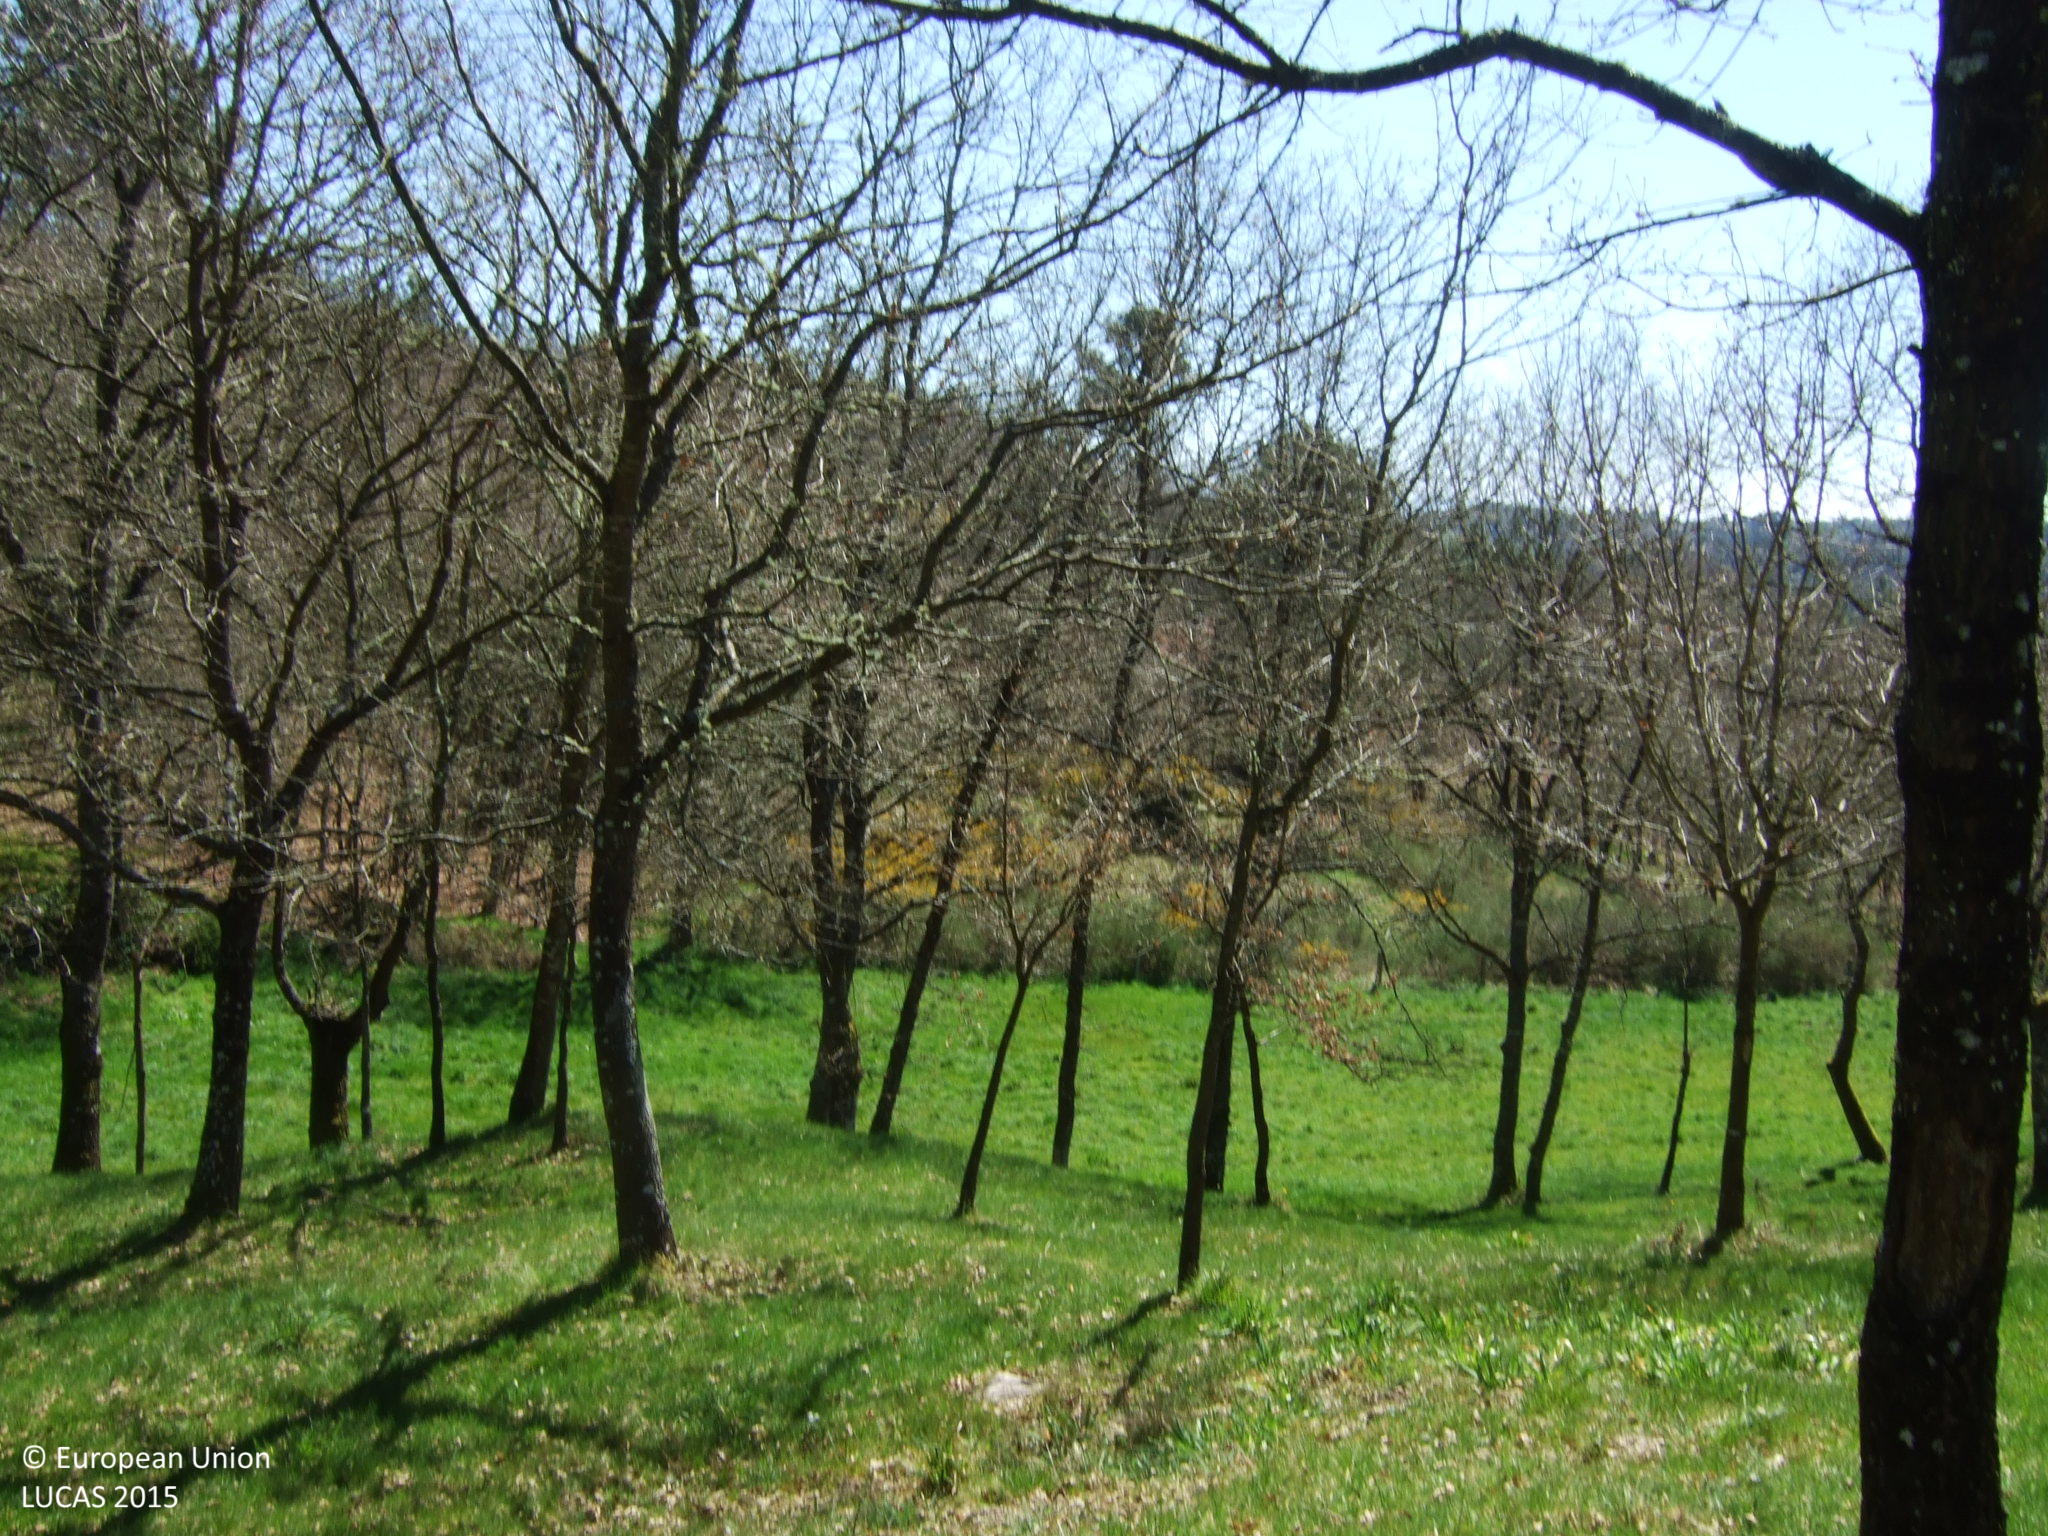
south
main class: Woodland
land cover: Broadleaved woodland
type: acidophilous oak and oak-birch forest
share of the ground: 50 - 75 %
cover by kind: broadleaved forest trees 55 %, herbaceous plants 45 %
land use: Forestry
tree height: > 5 m
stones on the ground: < 10 %
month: April
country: ES
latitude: 42.7310
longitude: -7.7522
